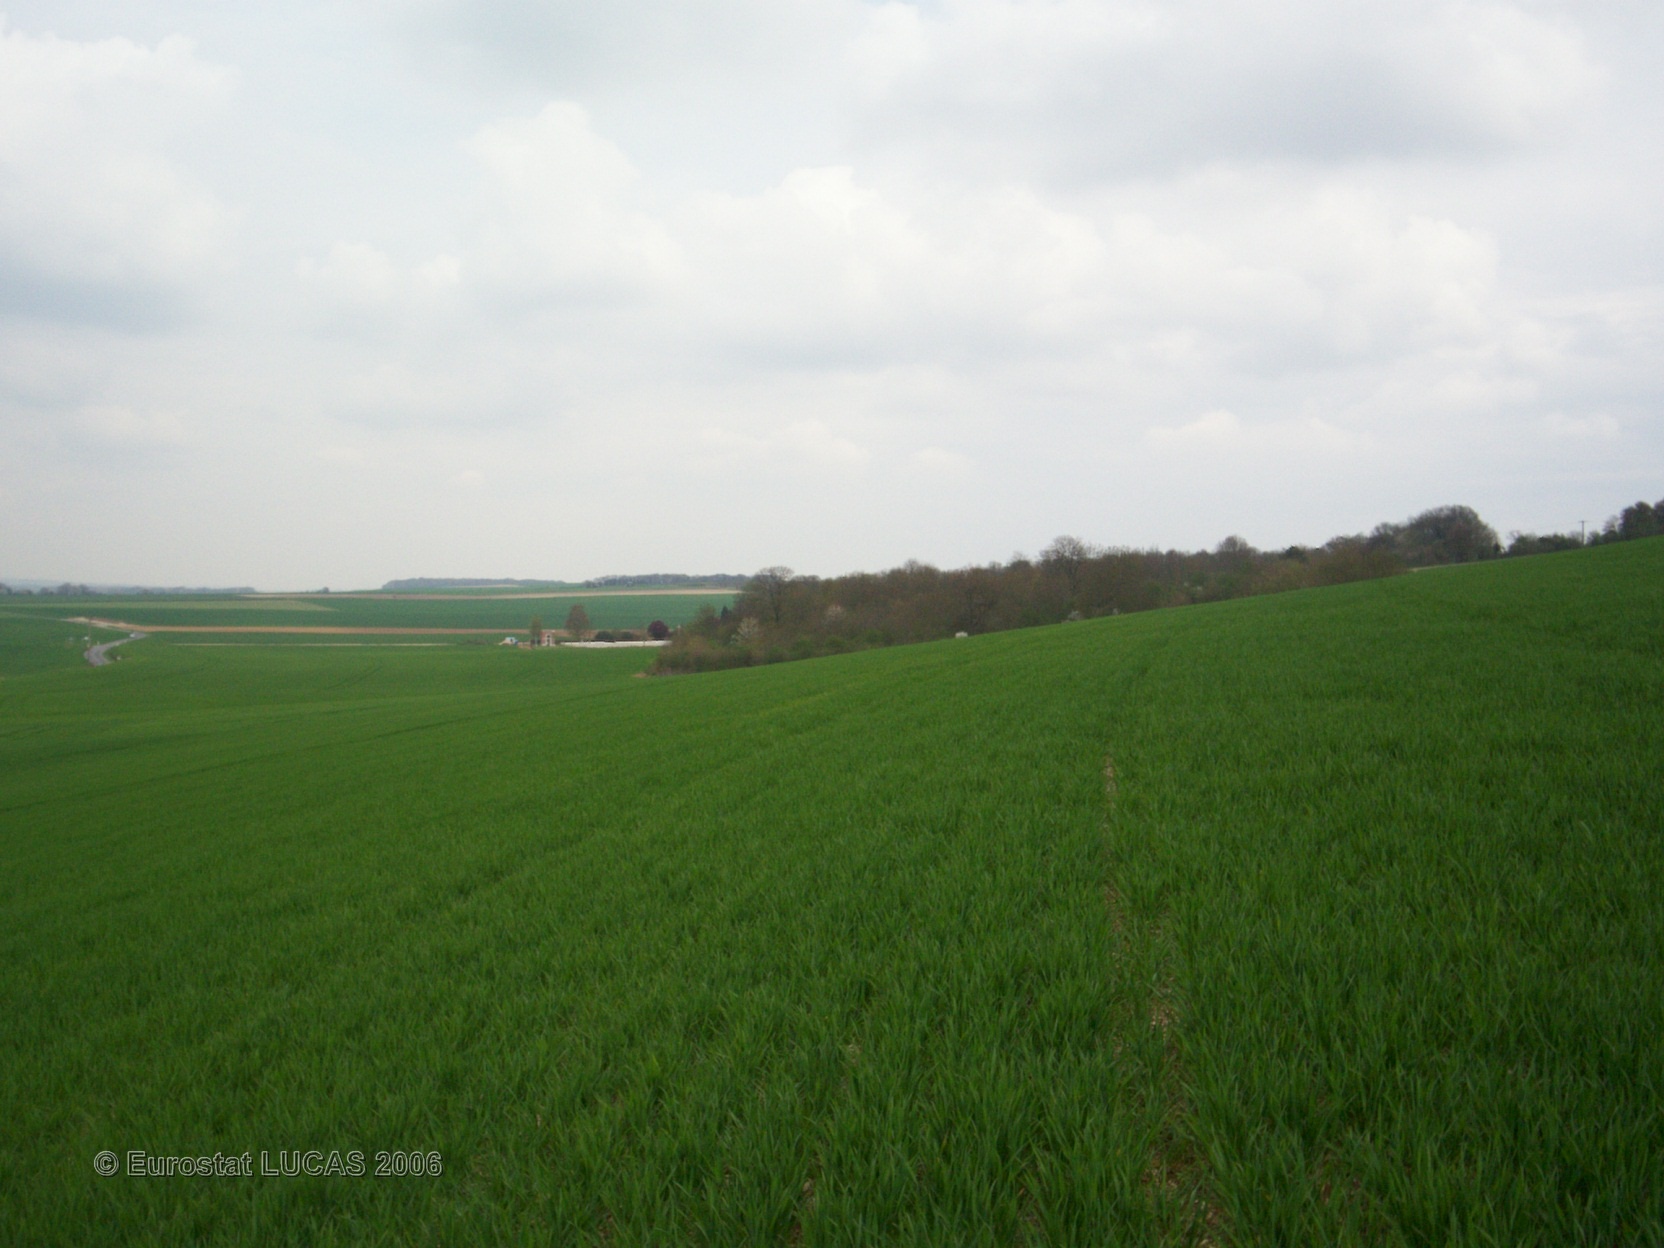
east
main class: Cropland
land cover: Common wheat
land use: Agriculture (excluding fallow land and kitchen gardens)
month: April
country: FR
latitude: 49.9393
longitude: 2.5334
